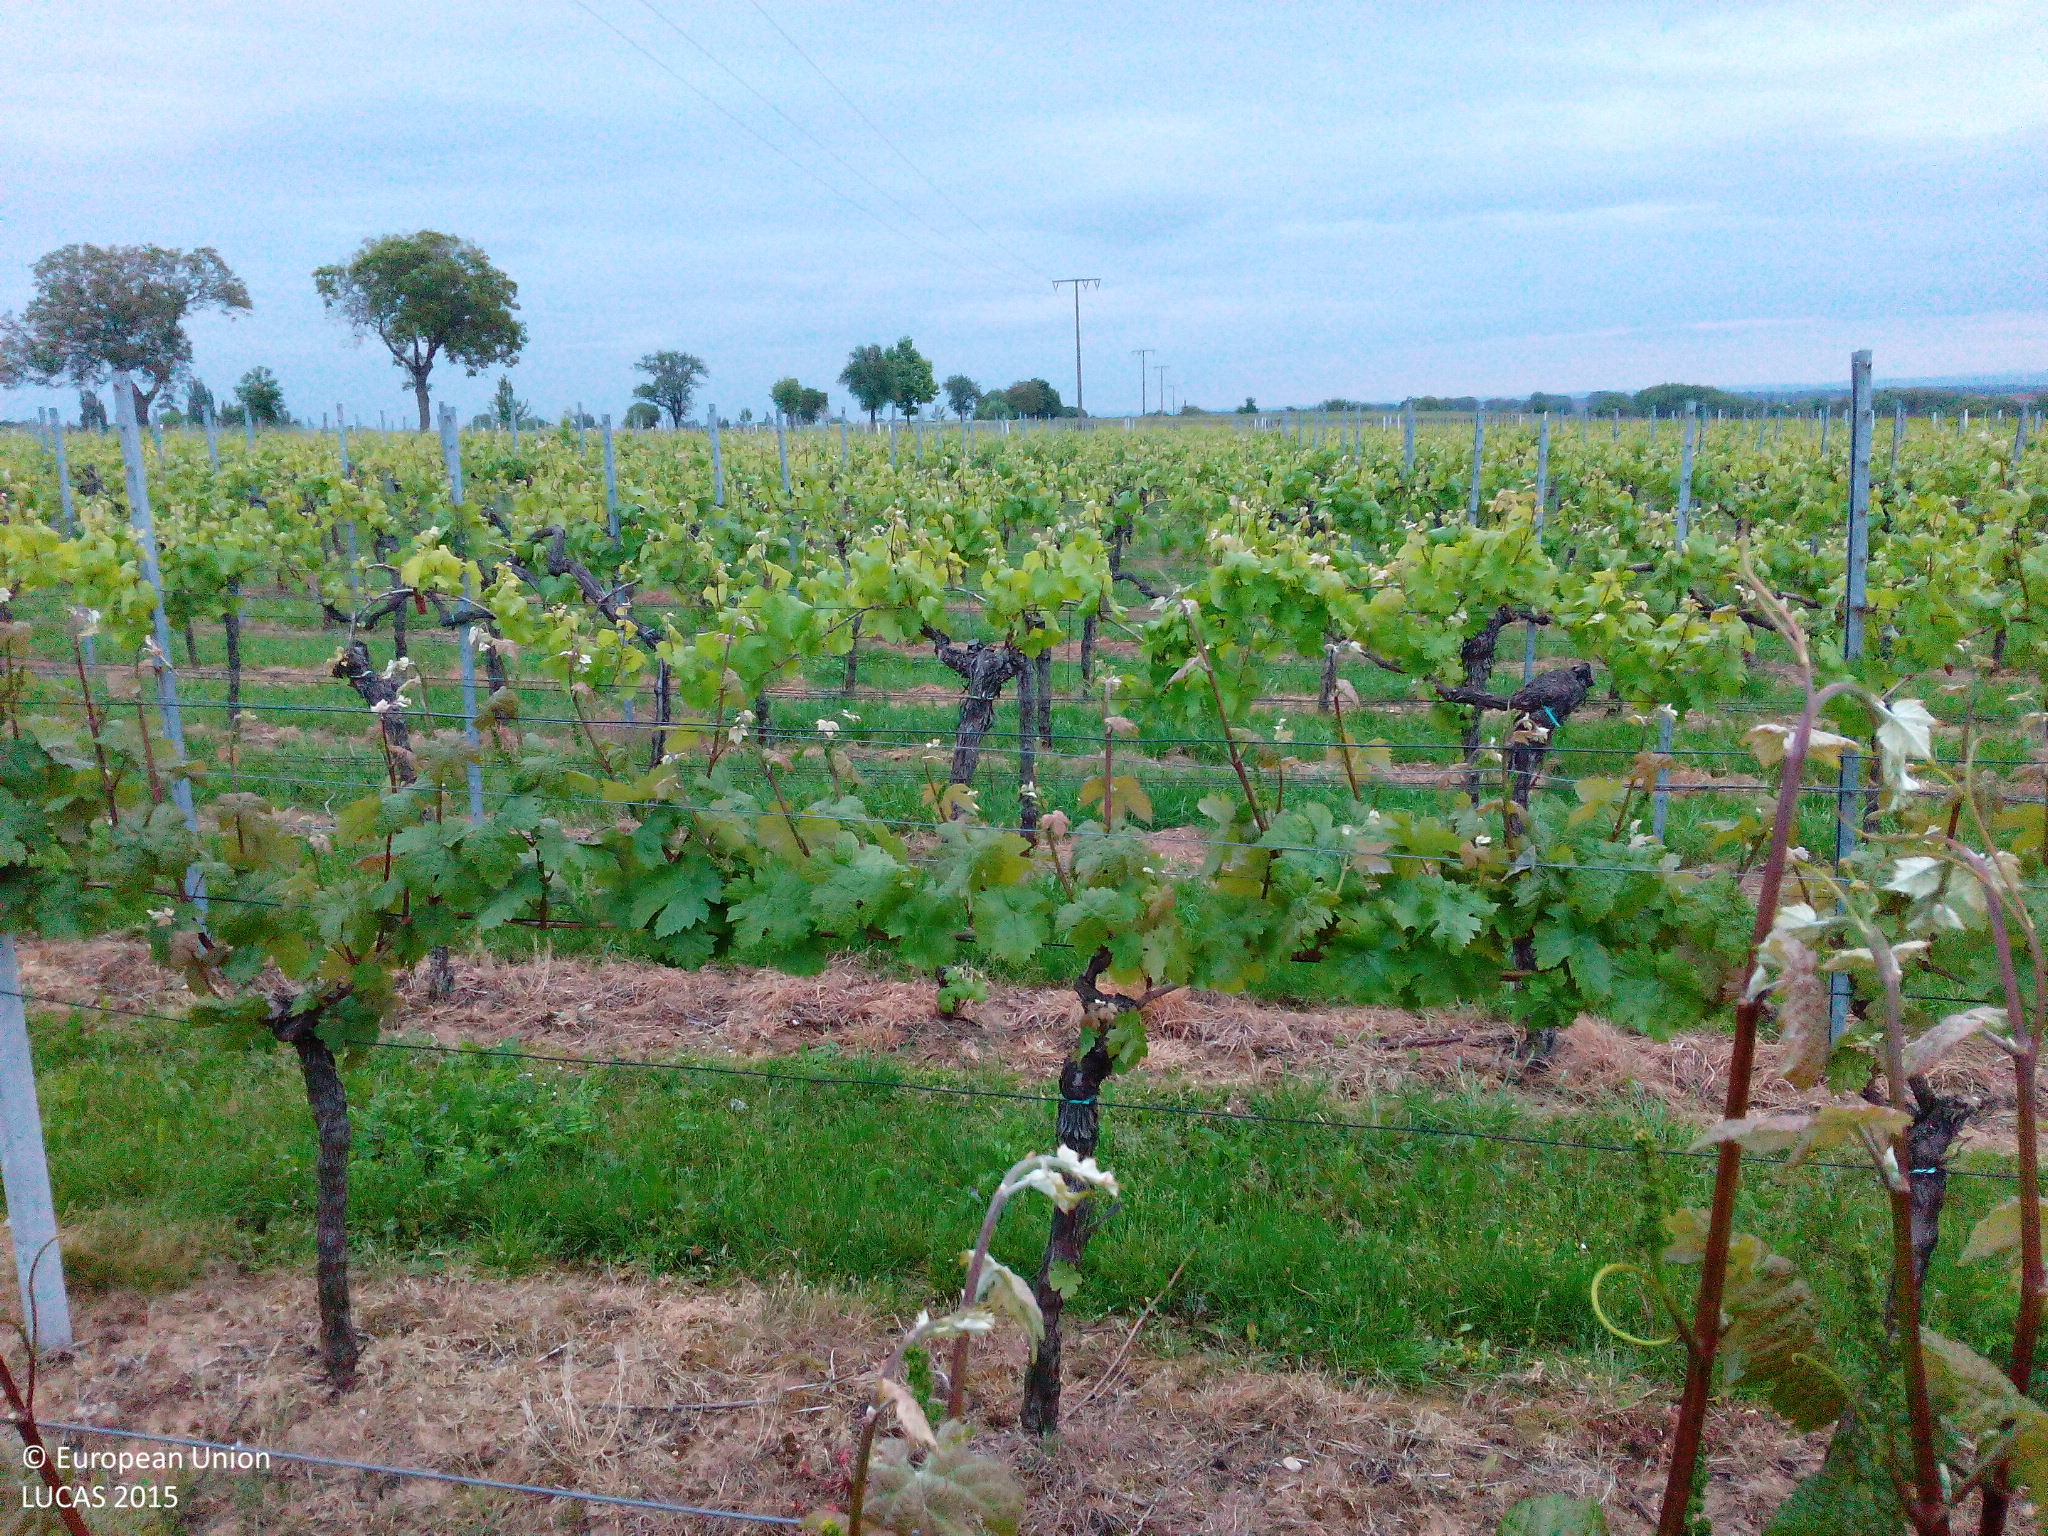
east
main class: Cropland
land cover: Vineyards
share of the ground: 25 - 50 %
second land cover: Grassland without tree/shrub cover
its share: 25 - 50 %
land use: Agriculture (excluding fallow land and kitchen gardens)
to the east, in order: Vineyards; Grassland without tree/shrub cover; Electric lines; Paved roads, cycling and walking lanes; Grass margins; Lines of trees; Spontaneously vegetated surfaces; Paved roads, cycling and walking lanes; Grassland without tree/shrub cover; Vineyards
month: May
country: DE
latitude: 49.1424
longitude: 8.0678
